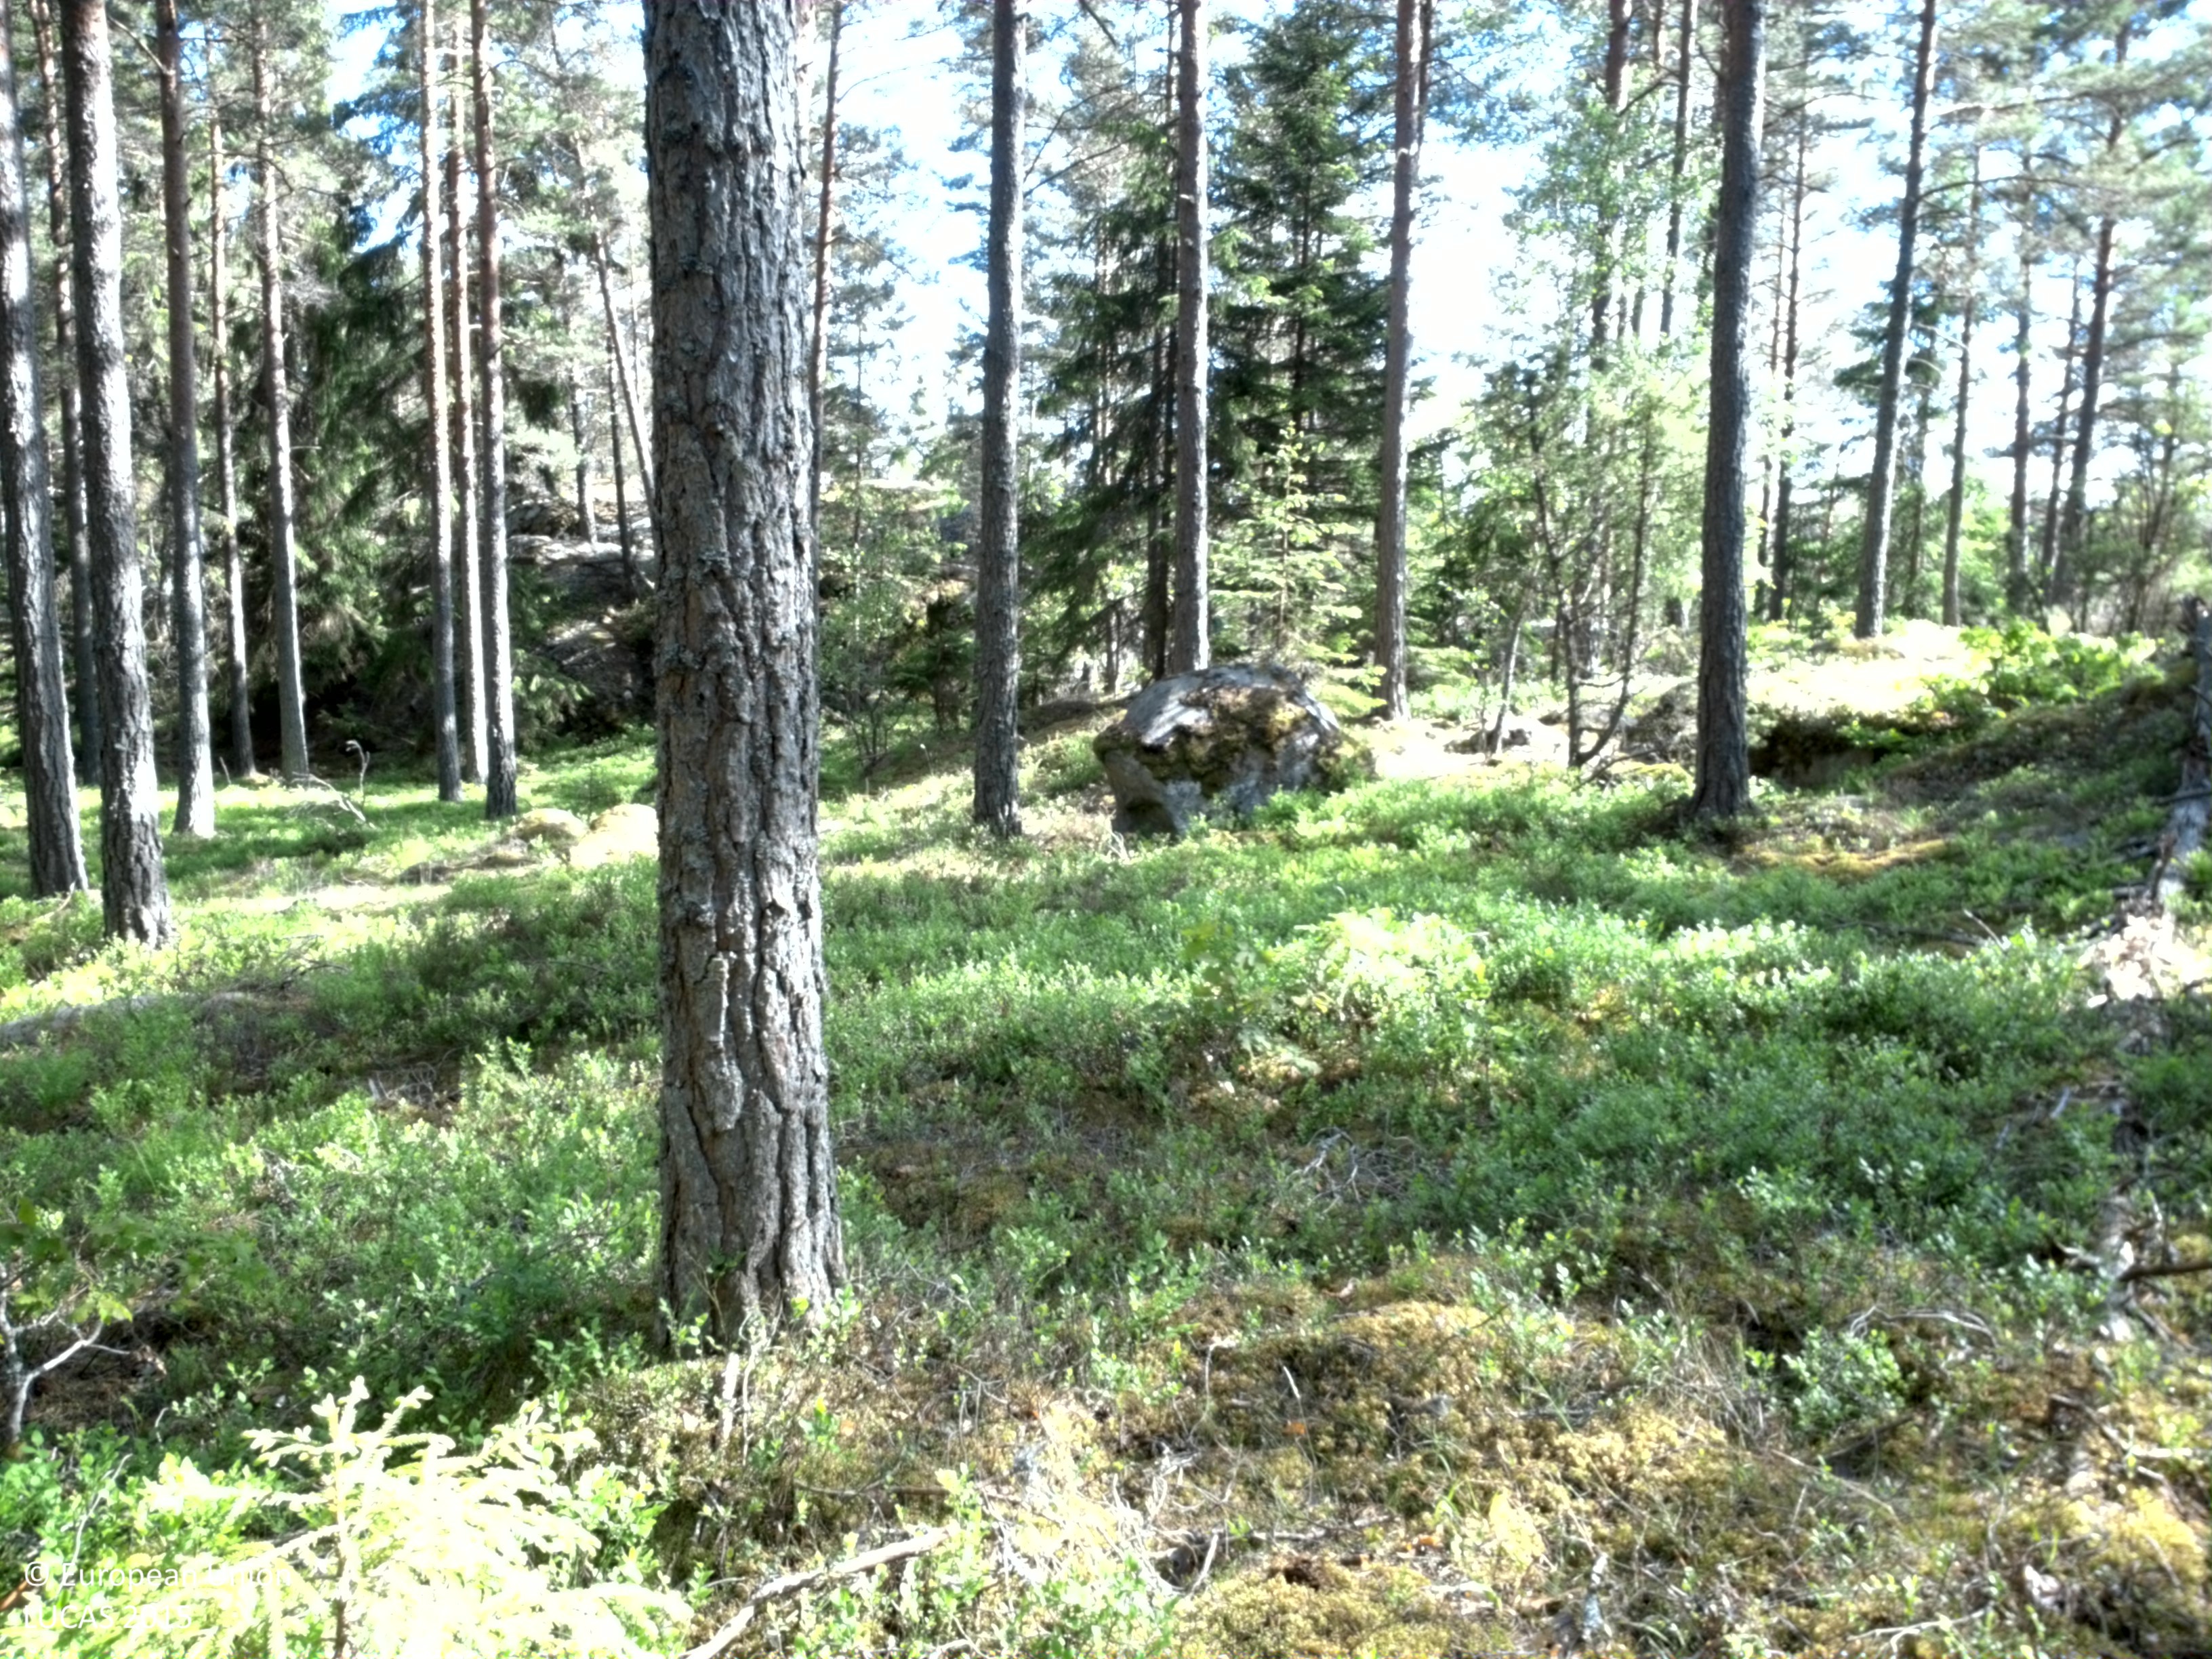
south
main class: Woodland
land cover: Pine dominated coniferous woodland
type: boreal forest
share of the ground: 25 - 50 %
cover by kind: herbaceous plants 45 %, coniferous forest trees 40 %, lichens and mosses 15 %
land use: Forestry
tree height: > 5 m
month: June
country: SE
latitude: 58.3963
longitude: 16.3091
